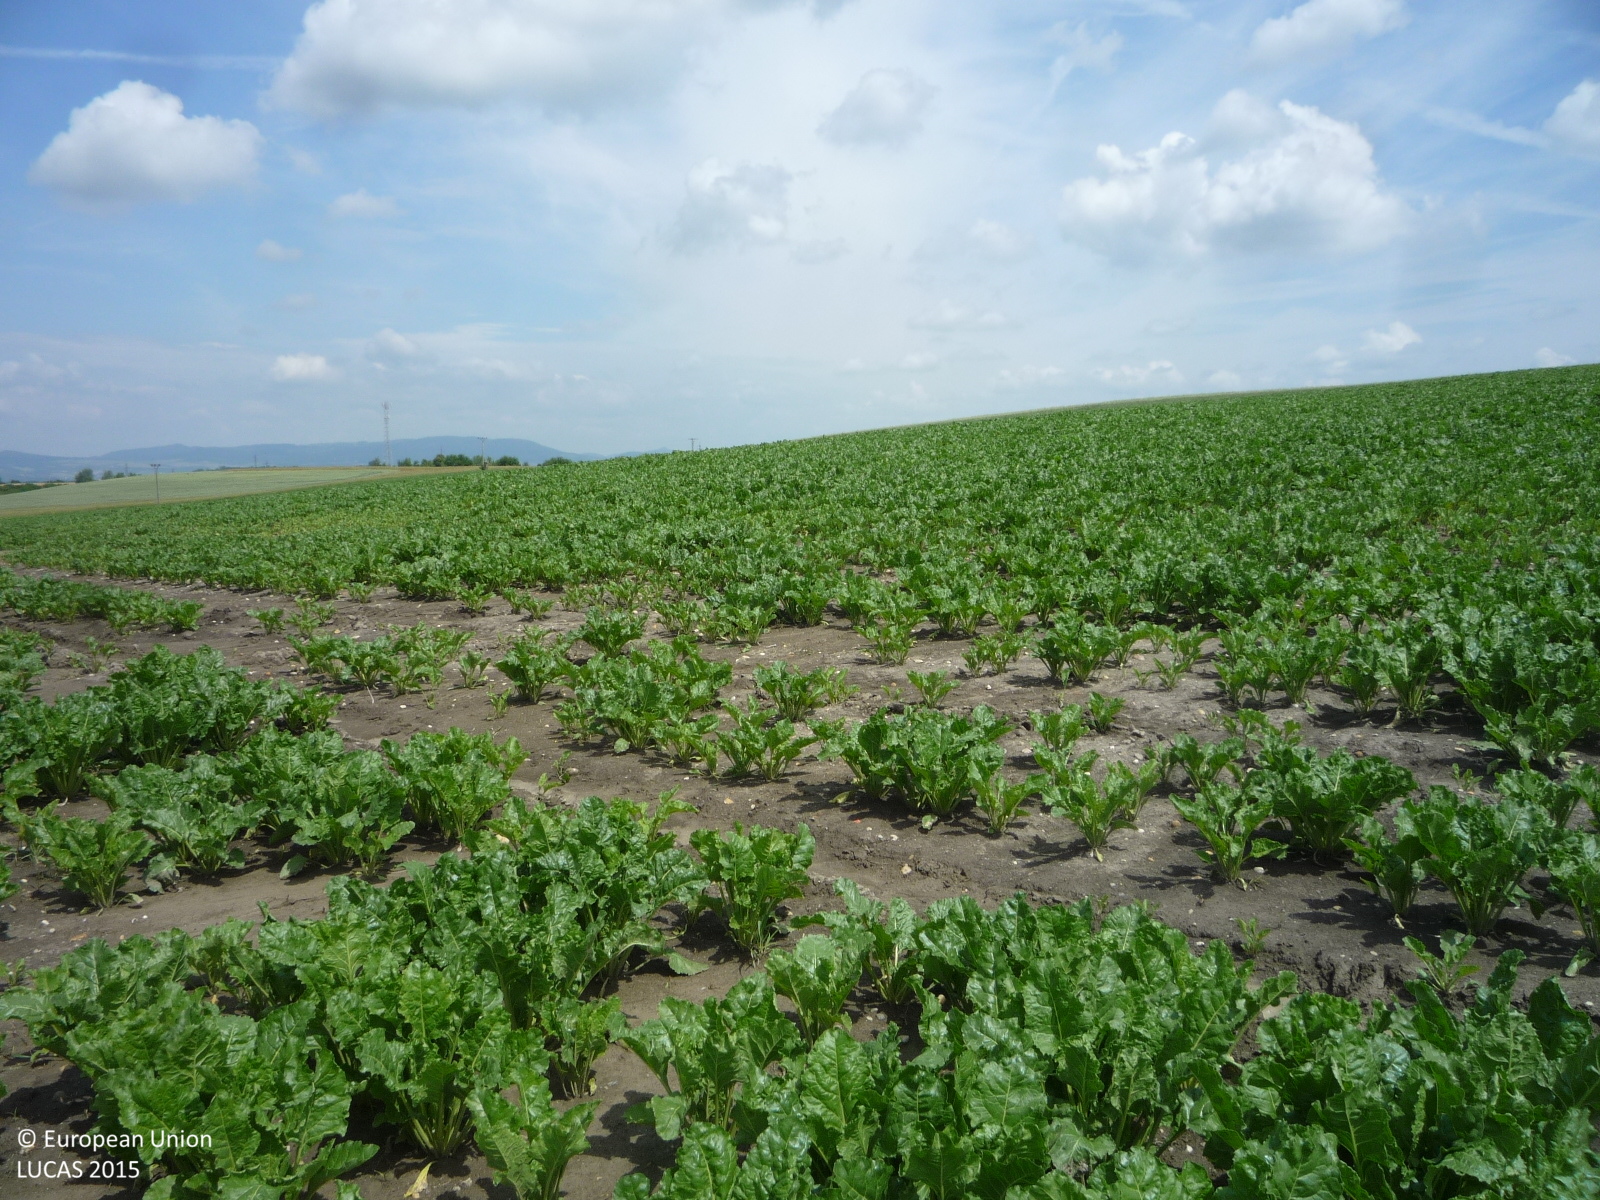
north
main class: Cropland
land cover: Sugar beet
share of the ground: > 75 %
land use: Agriculture (excluding fallow land and kitchen gardens)
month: June
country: CZ
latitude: 50.4317
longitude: 14.1824
